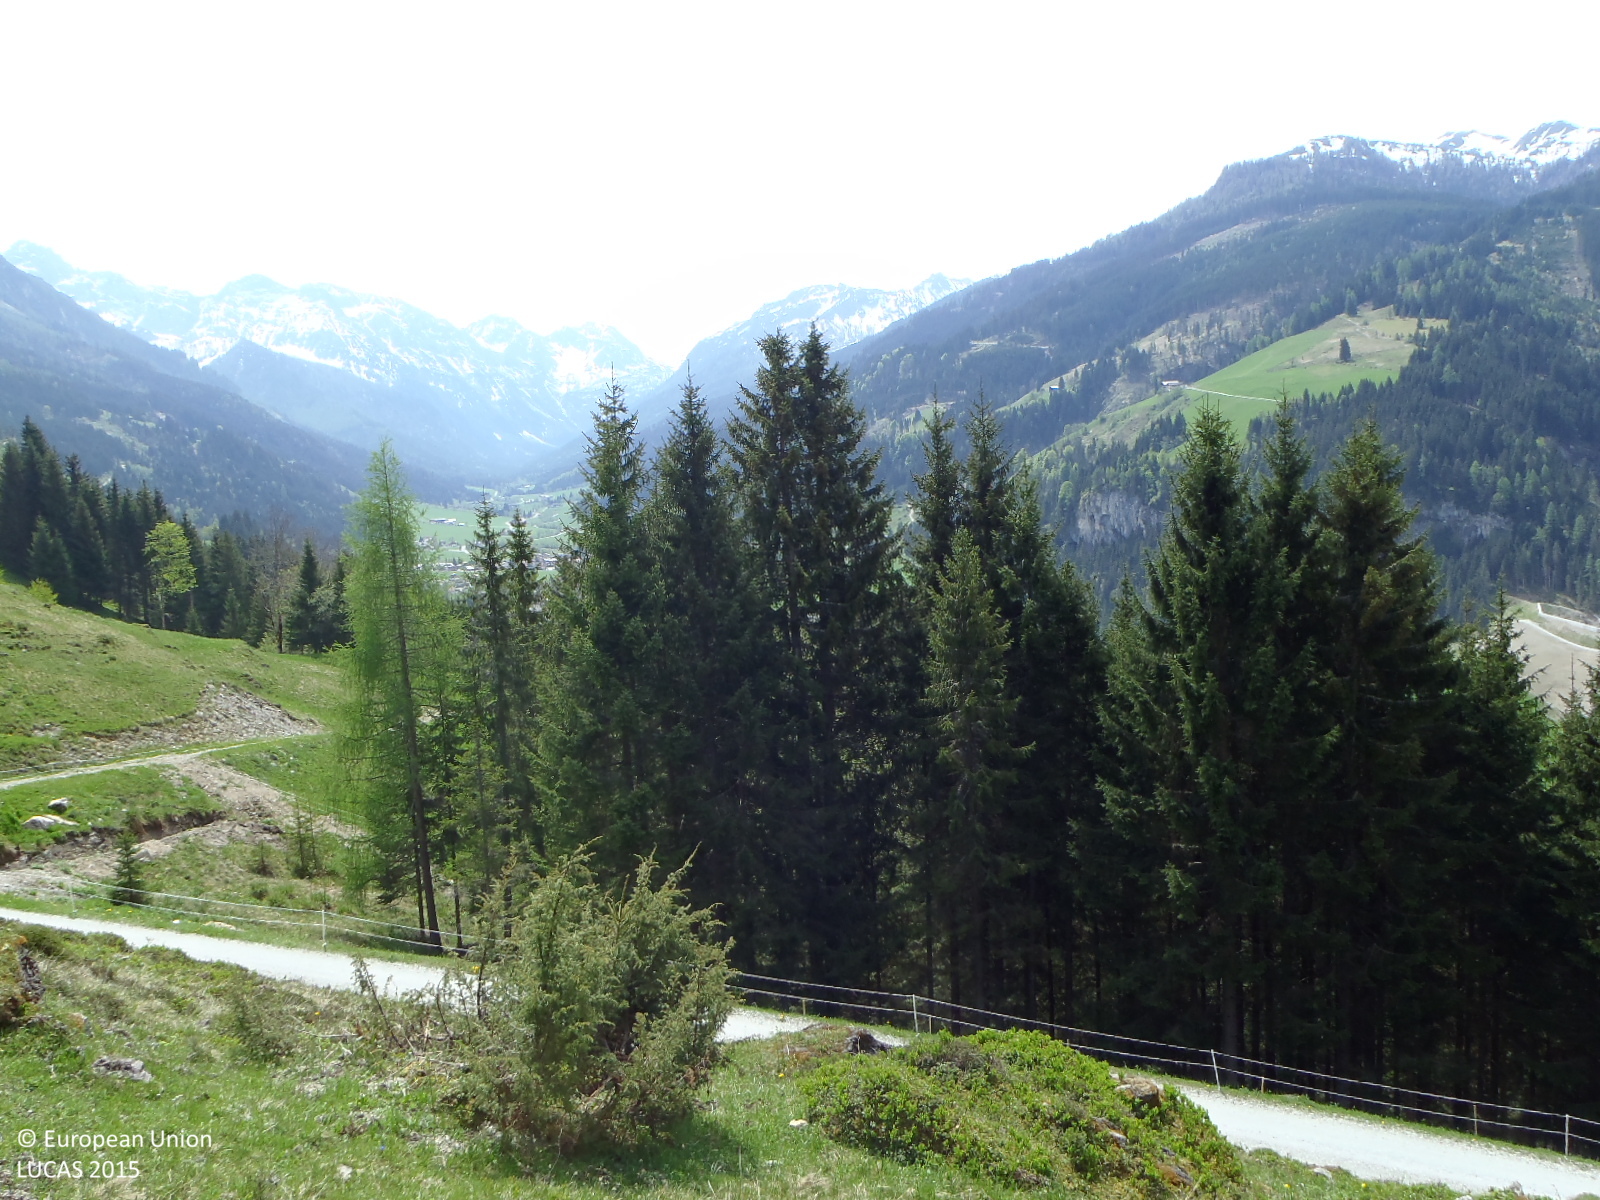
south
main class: Grassland
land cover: Grassland without tree/shrub cover
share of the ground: > 75 %
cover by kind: herbaceous plants 90 %, unconsolidated bare surface 10 %
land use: Agriculture (excluding fallow land and kitchen gardens)
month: May
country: AT
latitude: 47.2910
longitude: 13.3170
